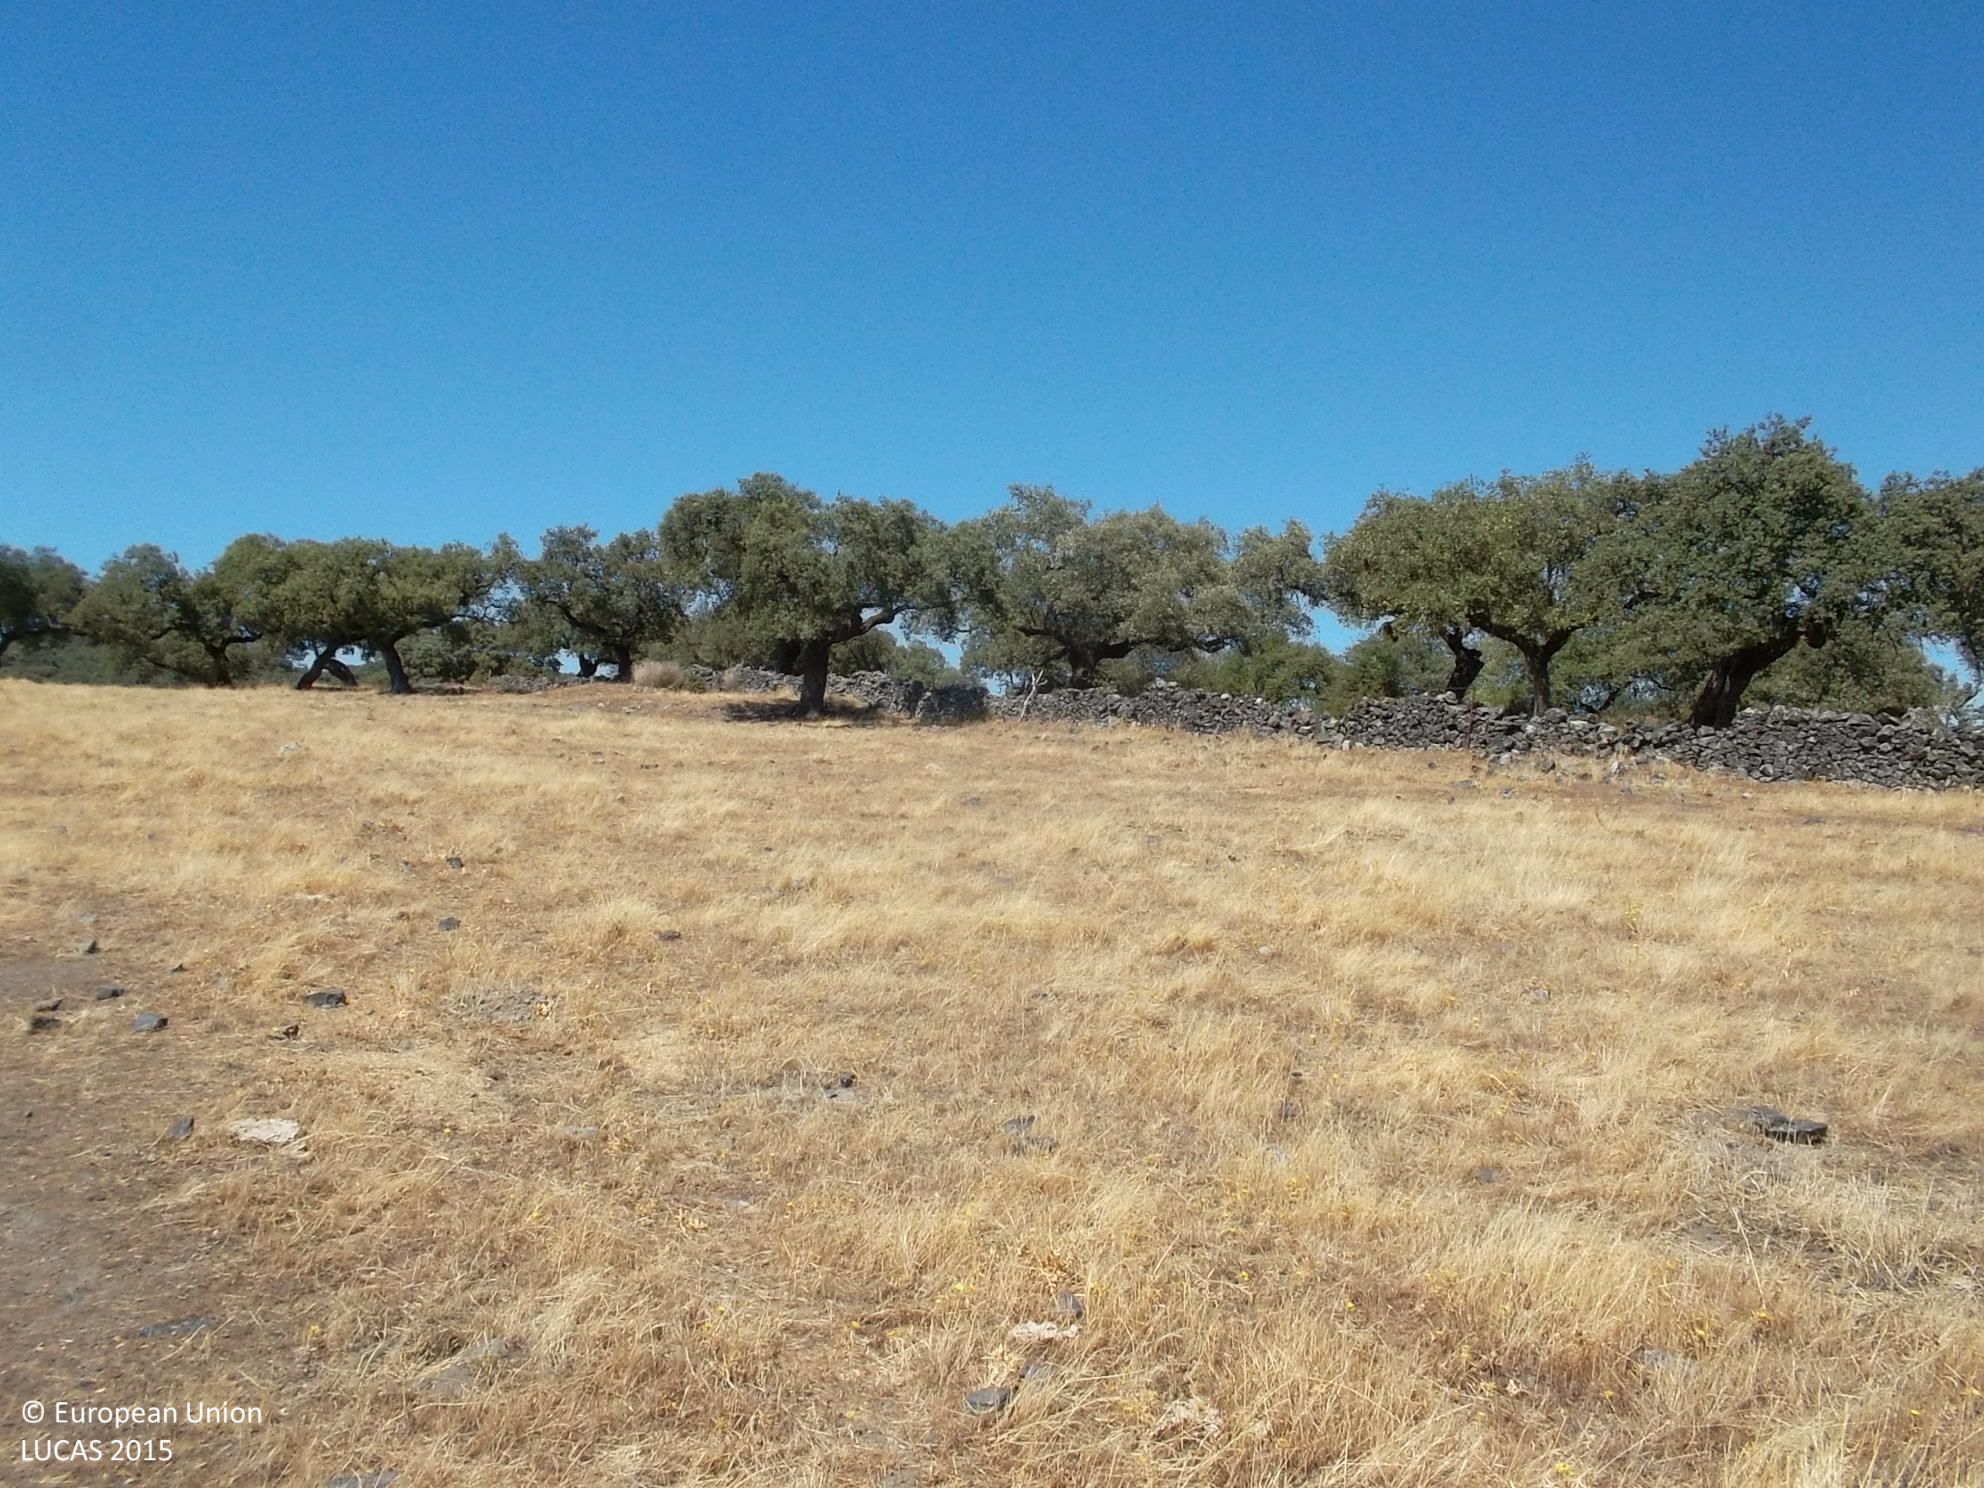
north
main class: Woodland
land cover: Broadleaved woodland
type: broadleaved evergreen forest
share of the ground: 10 - 25 %
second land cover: Grassland without tree/shrub cover
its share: > 75 %
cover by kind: herbaceous plants 85 %, broadleaved forest trees 15 %
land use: Forestry
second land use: Agriculture (excluding fallow land and kitchen gardens)
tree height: > 5 m
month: August
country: ES
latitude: 38.4330
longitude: -6.7247
